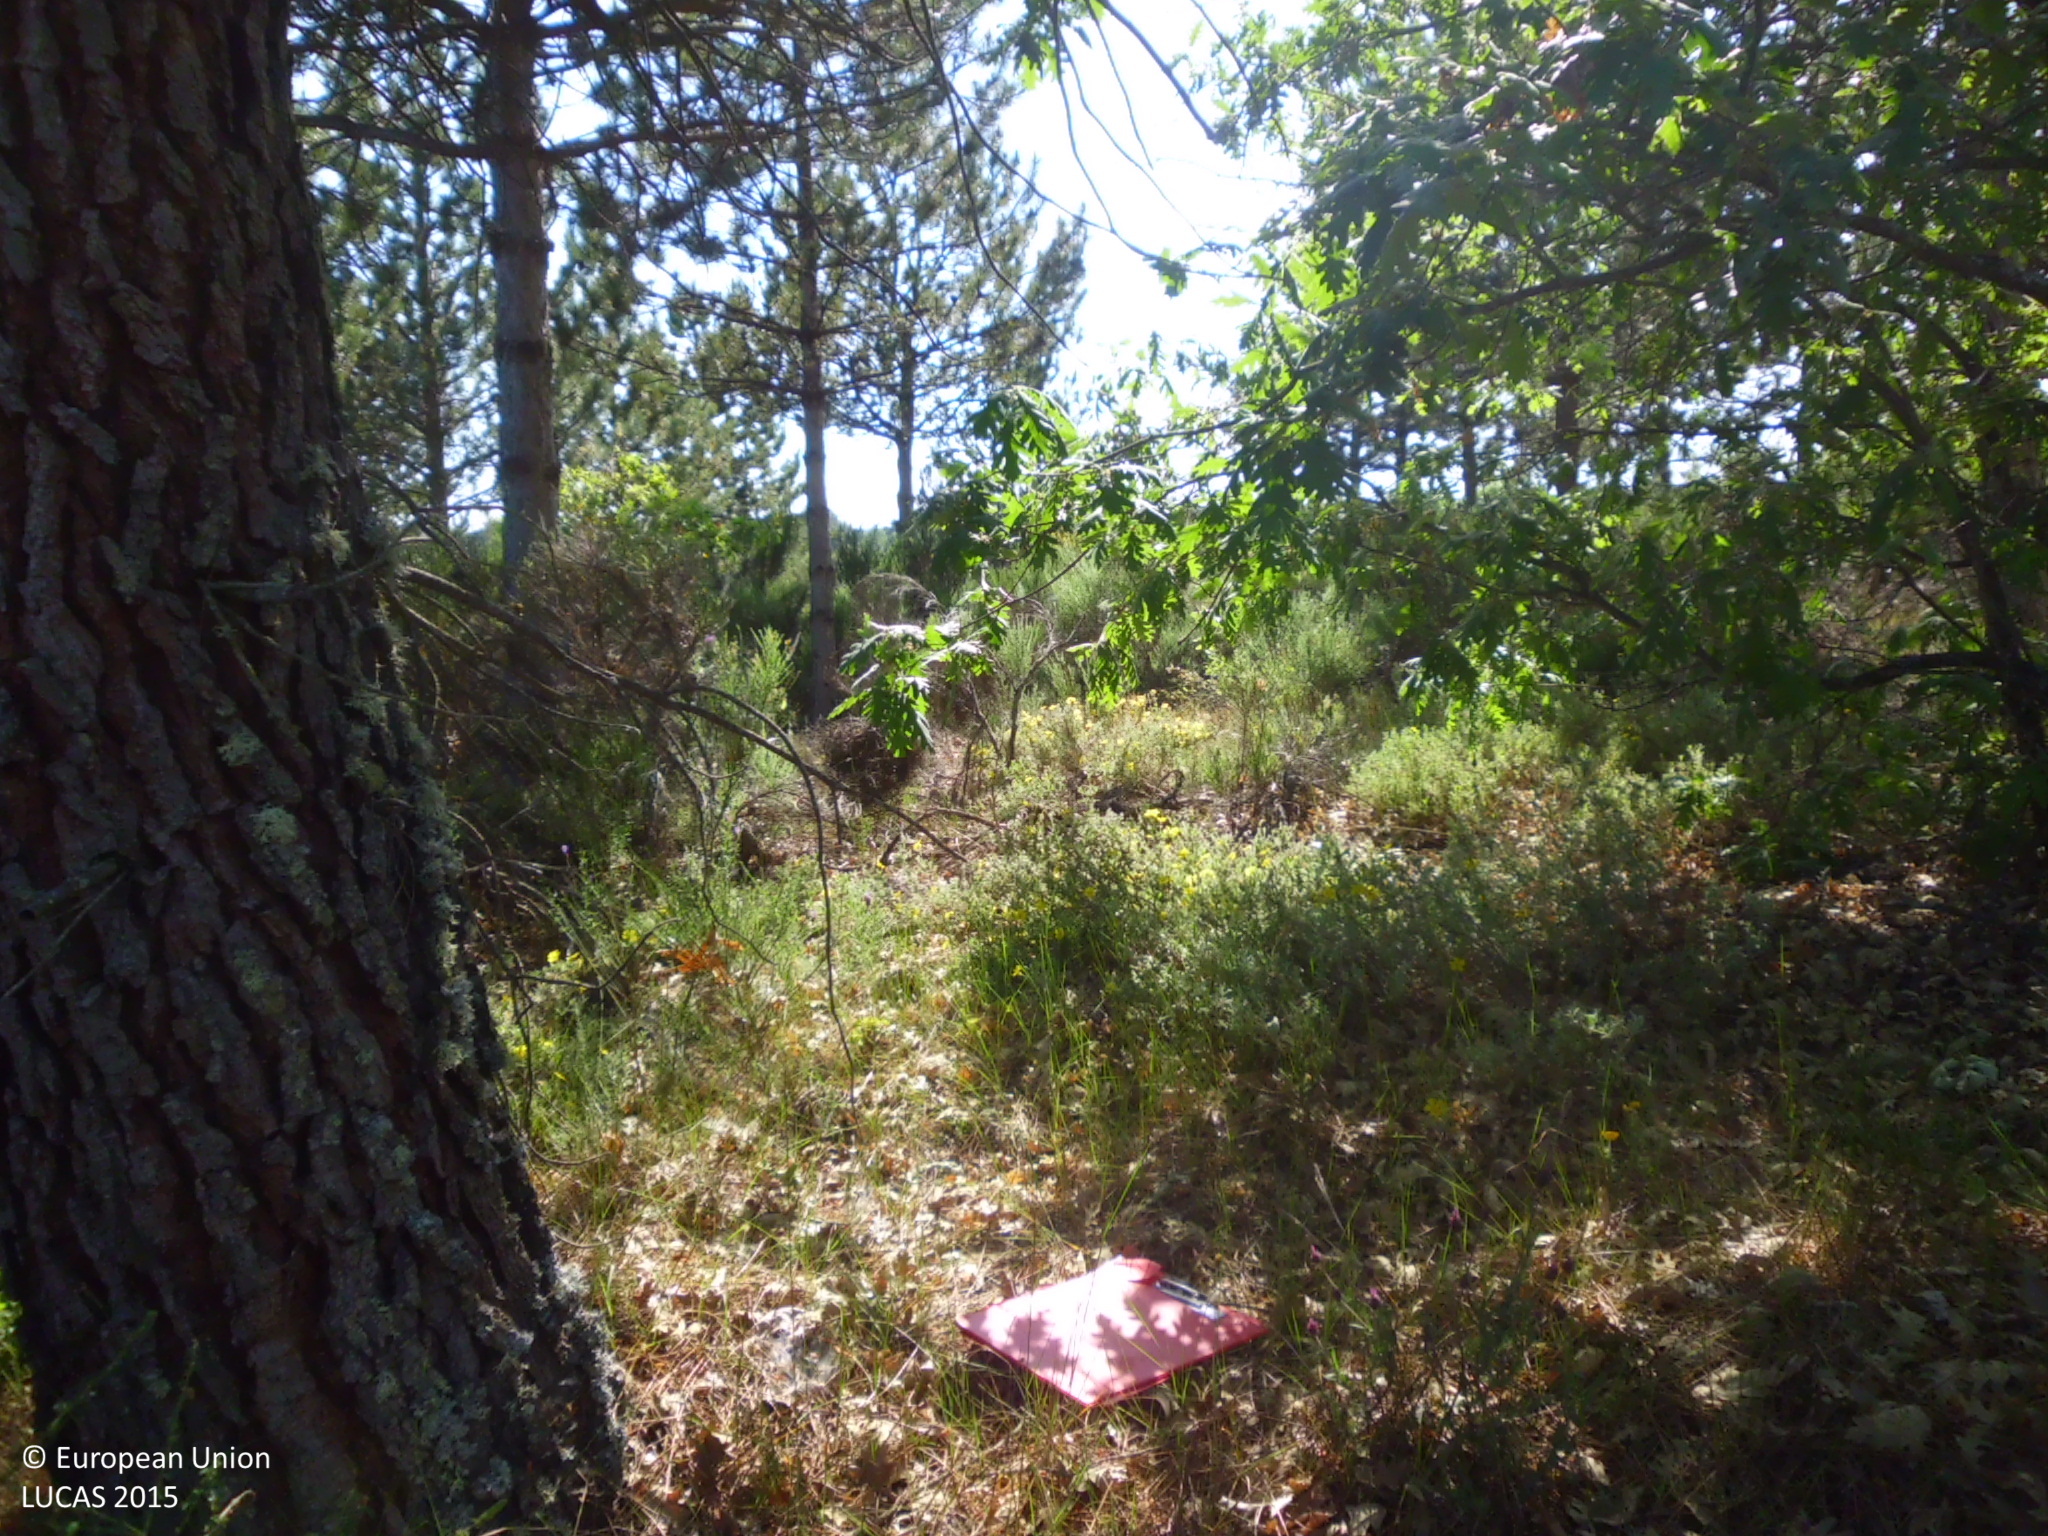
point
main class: Woodland
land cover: Pine dominated mixed woodland
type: coniferous forest of the mediterranean region
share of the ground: 50 - 75 %
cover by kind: coniferous forest trees 45 %, broadleaved forest trees 25 %, herbaceous plants 20 %, shrubs 10 %
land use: Forestry
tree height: > 5 m
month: May
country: ES
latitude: 42.7129
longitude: -5.4190
